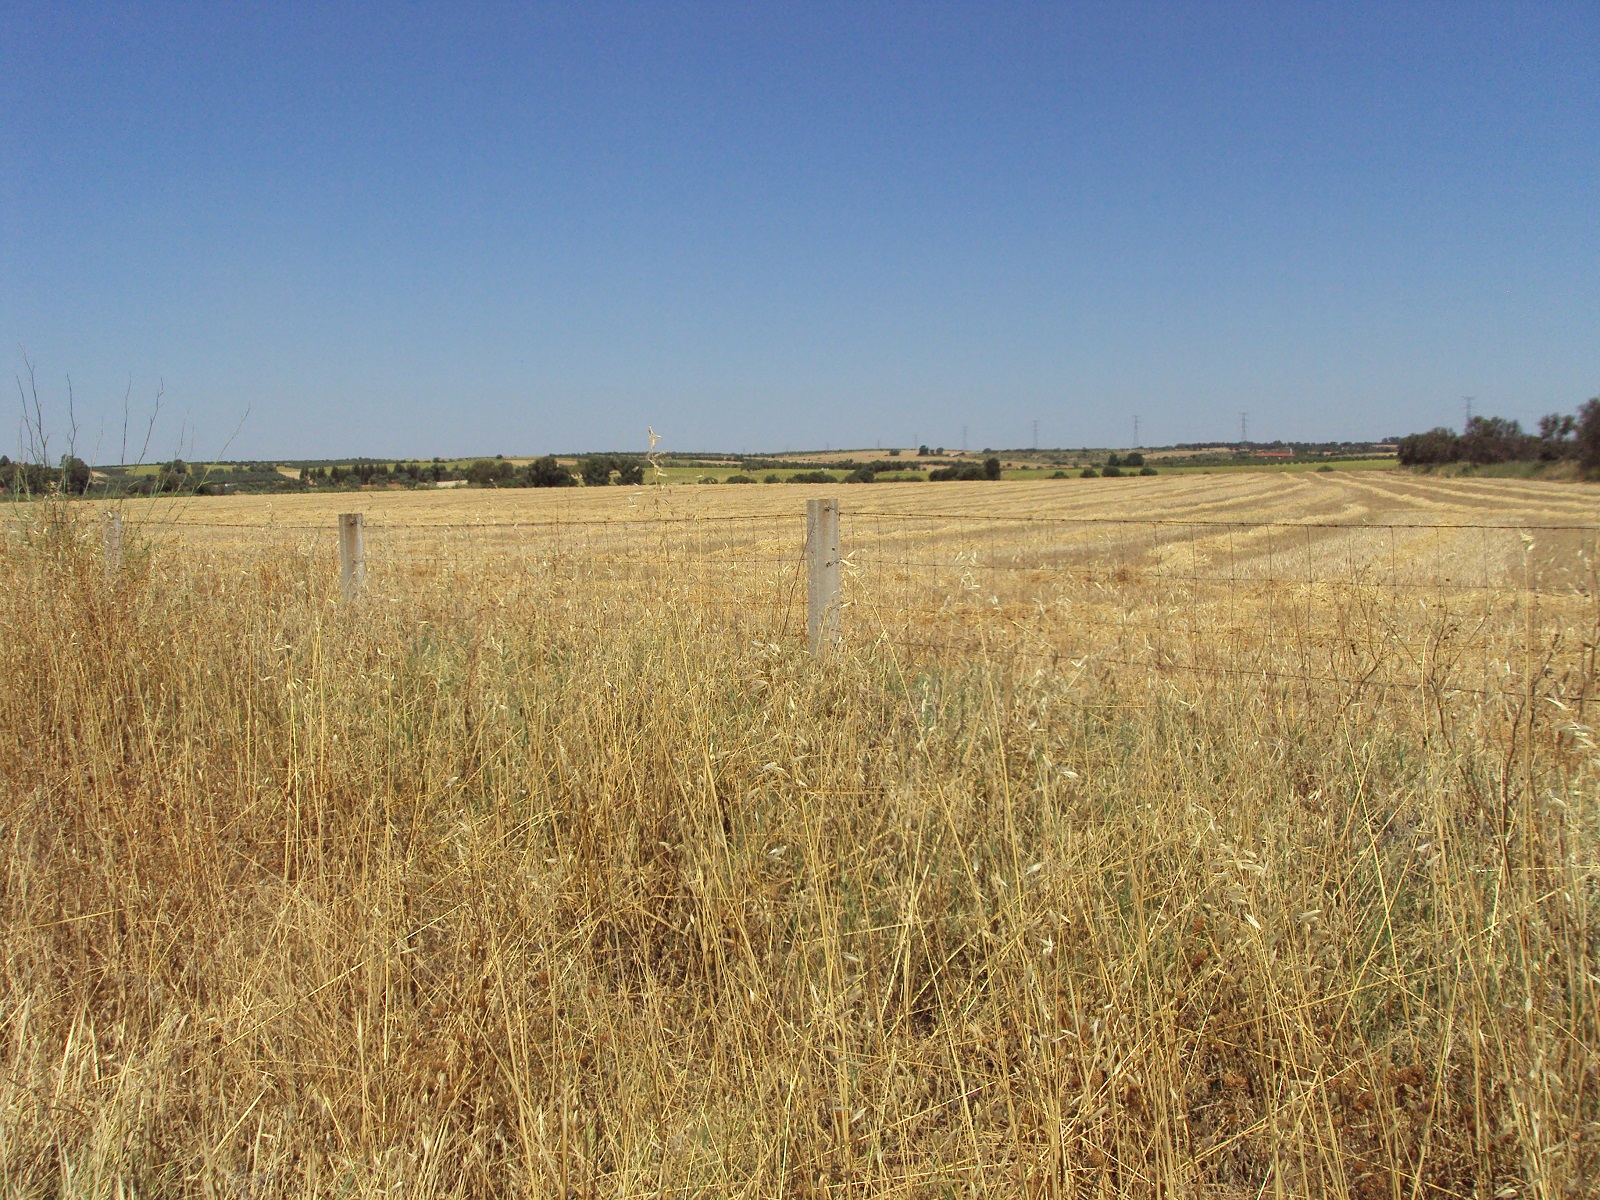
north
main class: Cropland
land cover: Durum wheat
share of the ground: > 75 %
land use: Agriculture (excluding fallow land and kitchen gardens)
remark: Harvested field
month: June
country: ES
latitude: 37.3864
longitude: -6.9025
